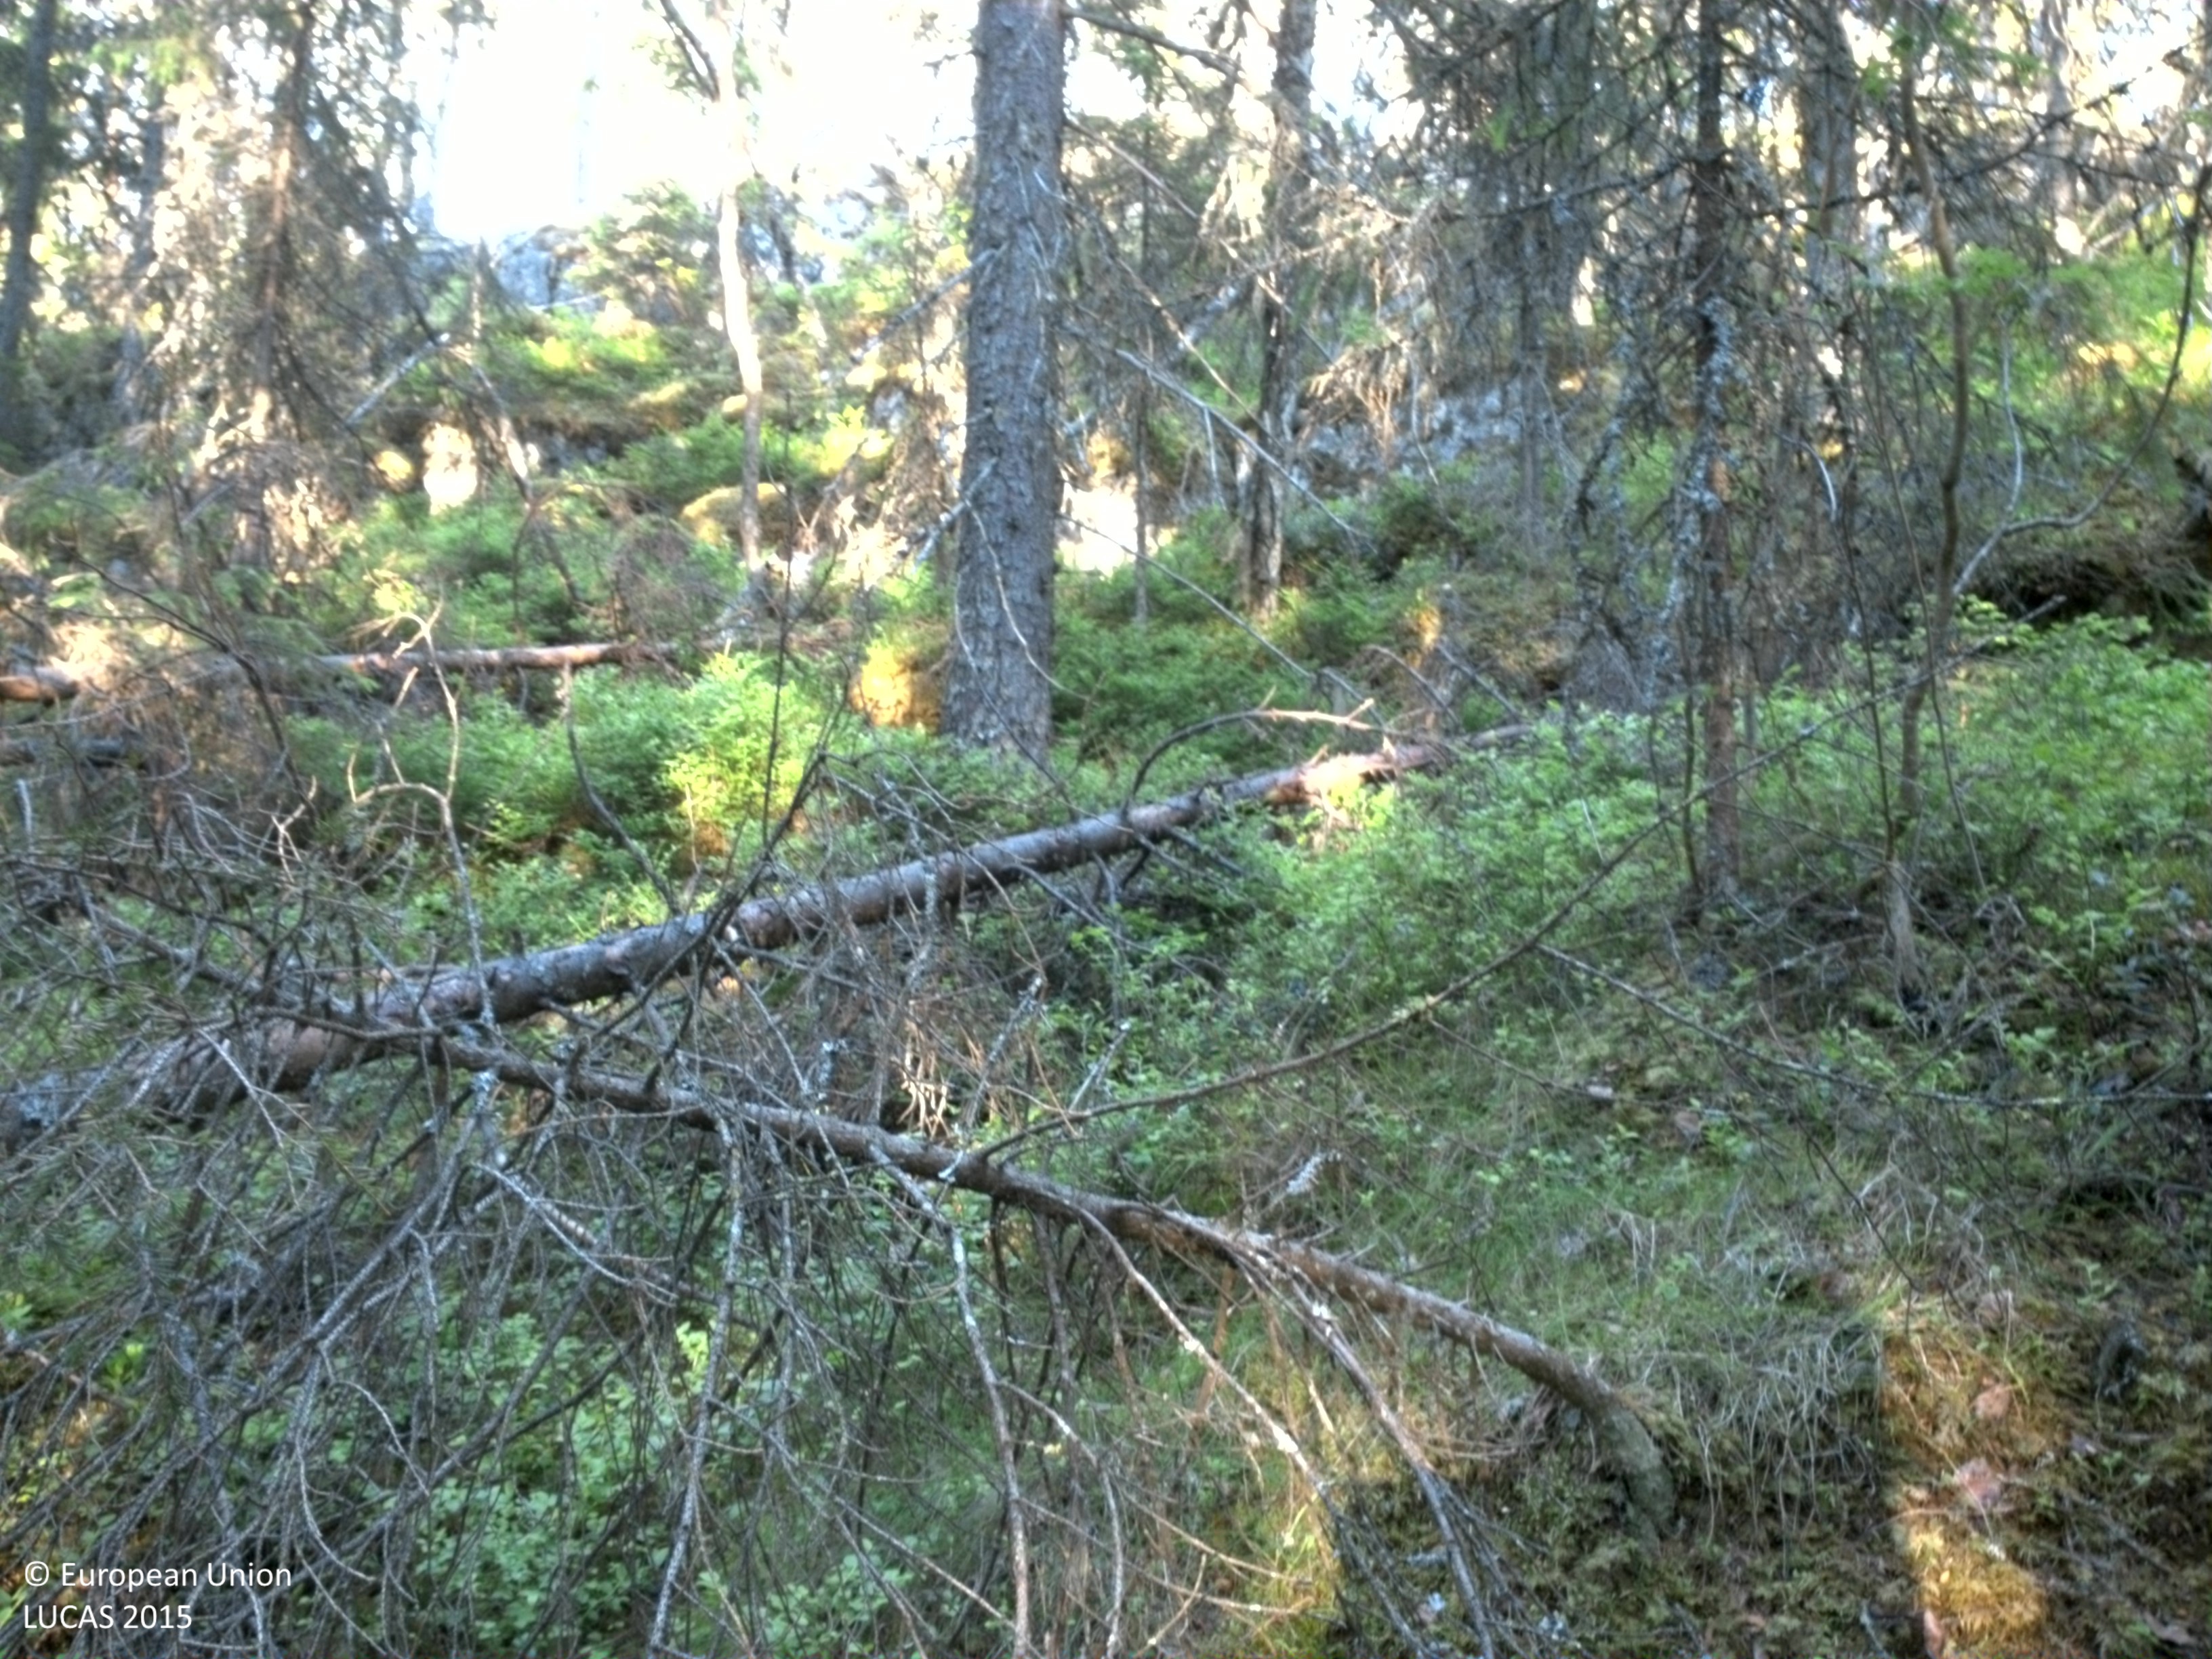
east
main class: Woodland
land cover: Spruce dominated coniferous woodland
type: boreal forest
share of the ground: 50 - 75 %
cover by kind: coniferous forest trees 70 %, shrubs 25 %, lichens and mosses 5 %
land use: Forestry
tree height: > 5 m
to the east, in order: Spruce dominated coniferous woodland; Pine dominated coniferous woodland; Spruce dominated coniferous woodland; Shrubland without tree cover; Dry stone walls; Shruby margins; Grass margins; Tracks; Grassland without tree/shrub cover; Broadleaved woodland; Other coniferous woodland
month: June
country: SE
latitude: 64.2759
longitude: 20.6563
